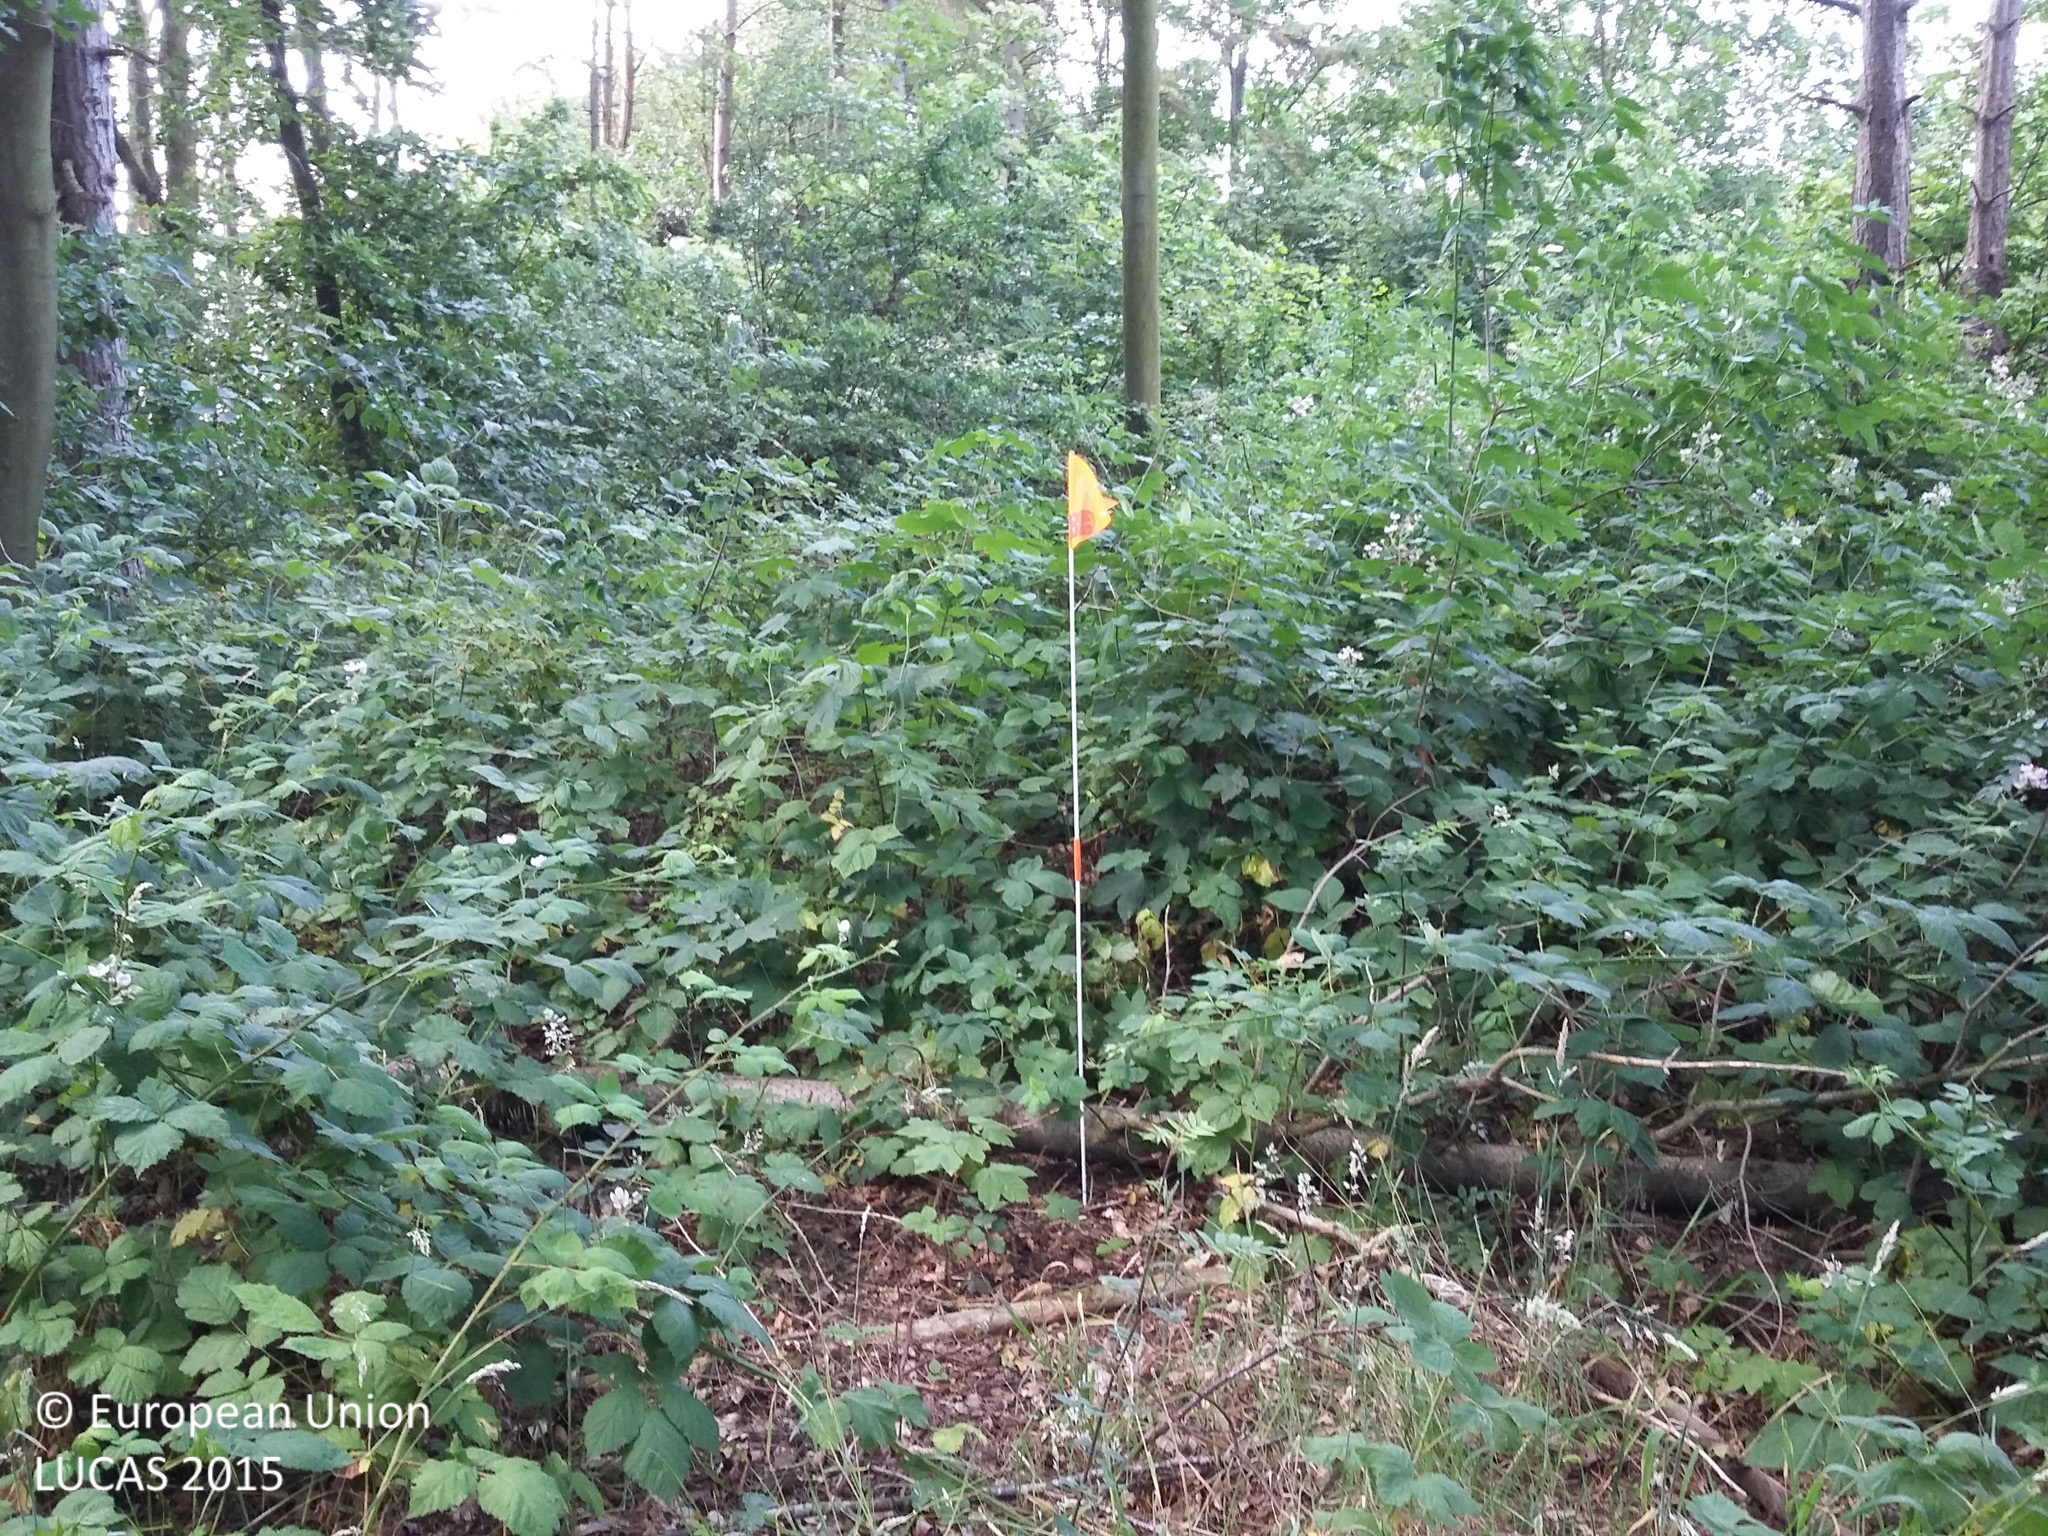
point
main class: Woodland
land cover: Other mixed woodland
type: beech forest
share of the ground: > 75 %
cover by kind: coniferous forest trees 45 %, broadleaved forest trees 30 %, herbaceous plants 20 %, shrubs 5 %
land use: Forestry
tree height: > 5 m
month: July
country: DK
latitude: 55.9242
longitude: 11.7426
